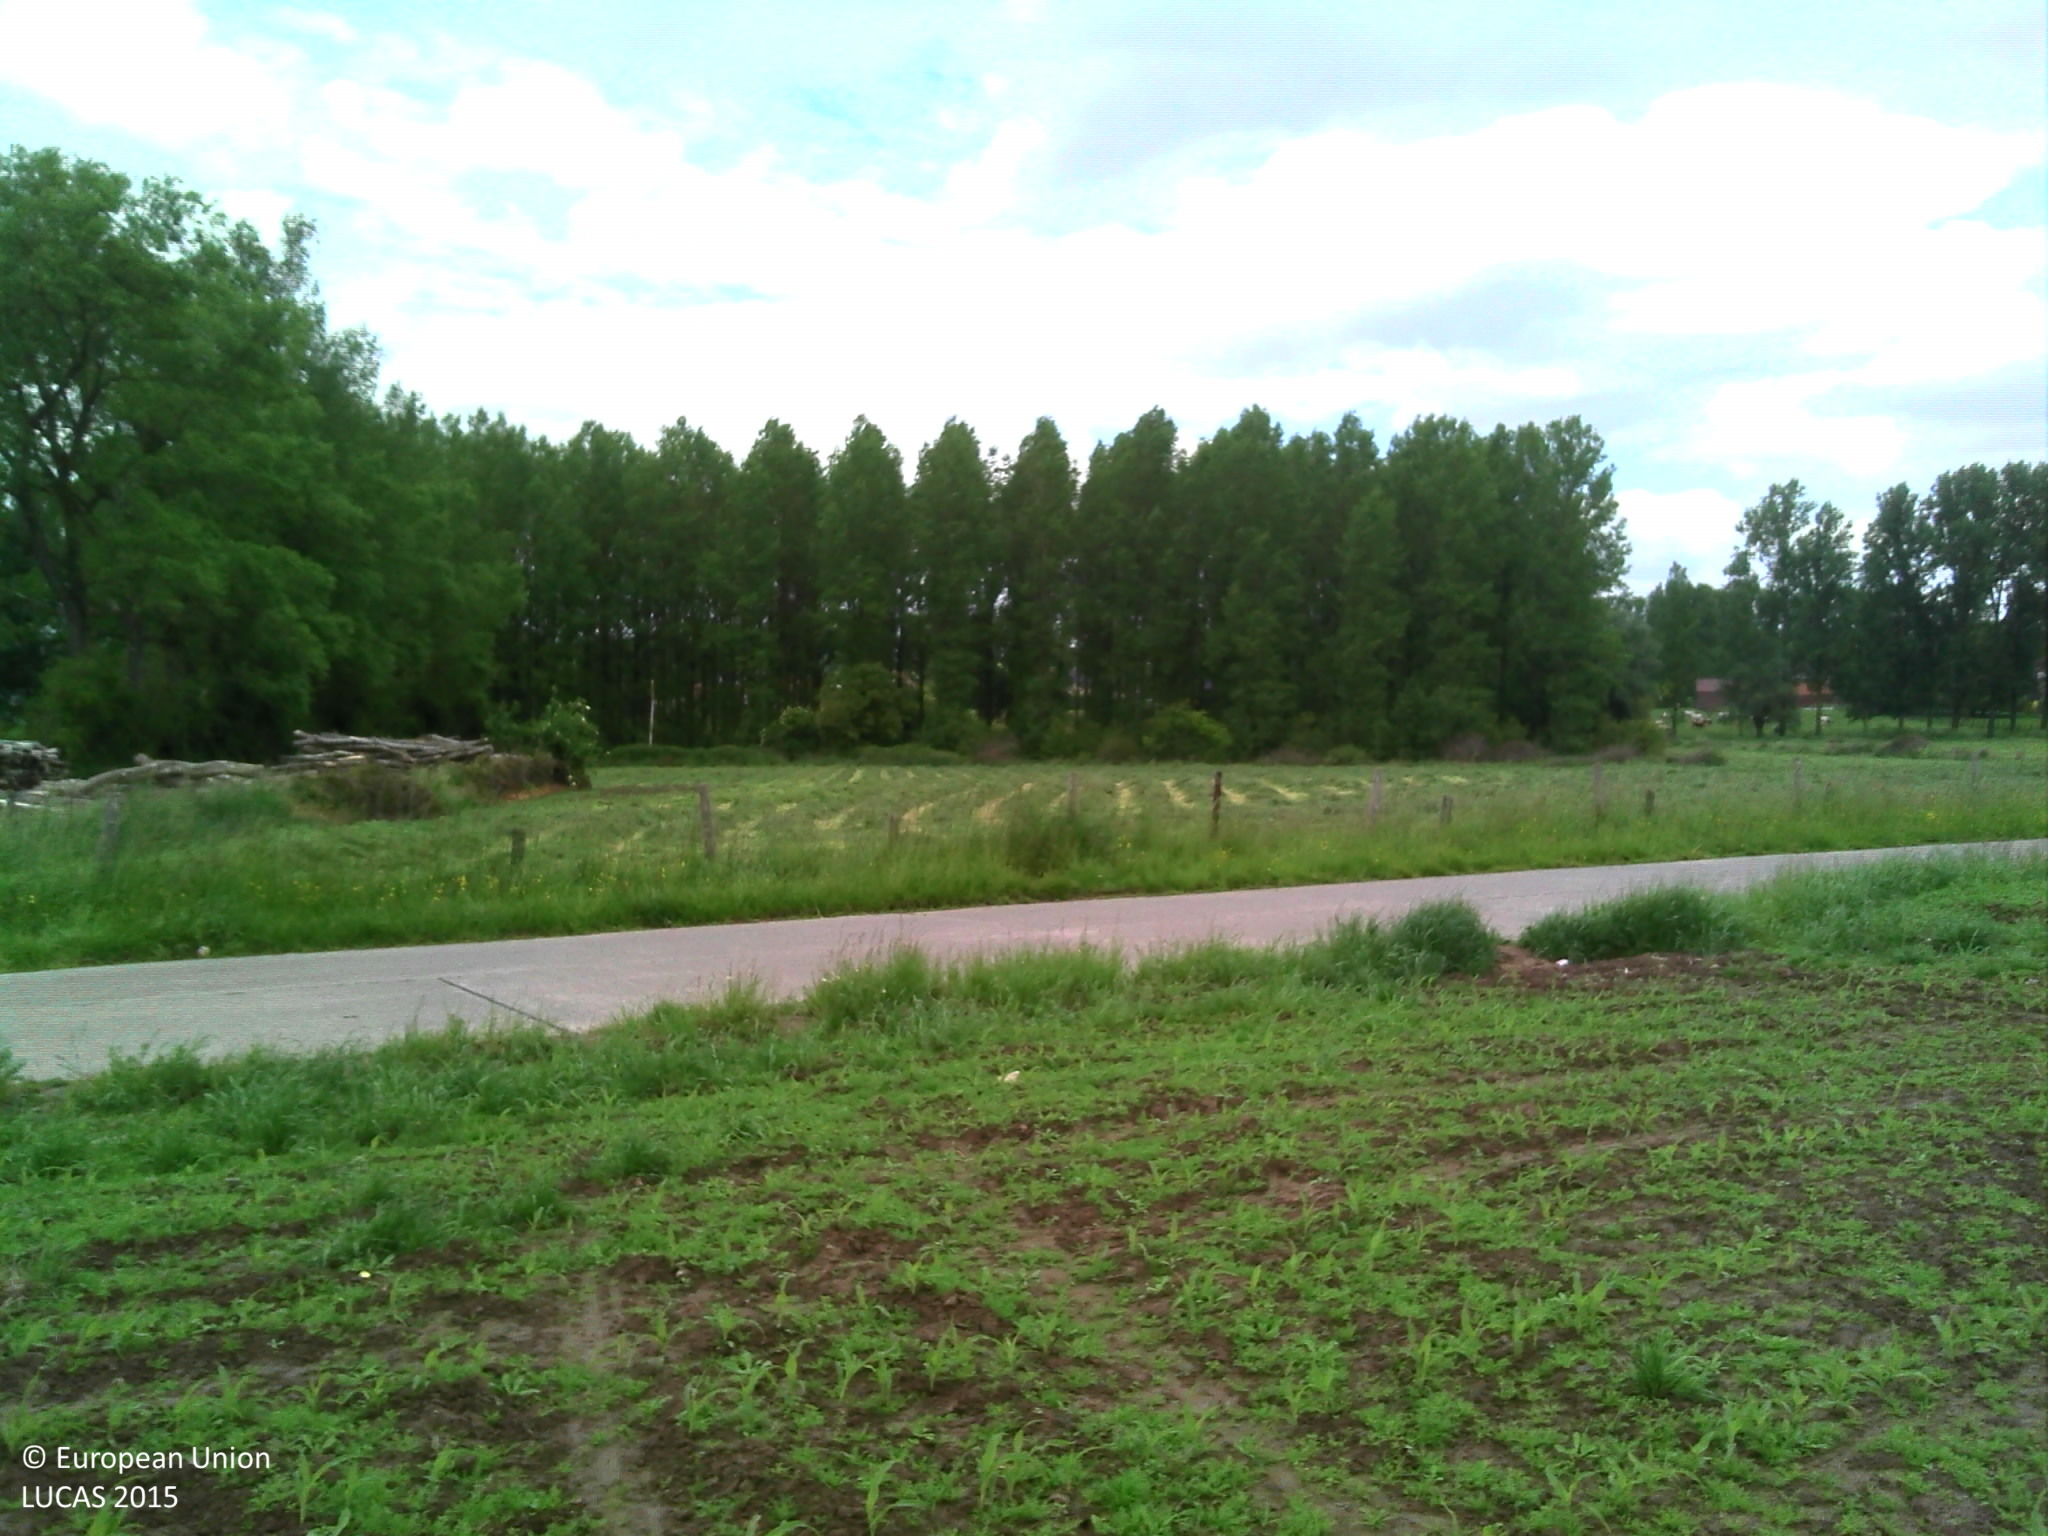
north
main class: Cropland
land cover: Maize
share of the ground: 10 - 25 %
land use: Agriculture (excluding fallow land and kitchen gardens)
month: June
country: BE
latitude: 50.8131
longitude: 3.8767
